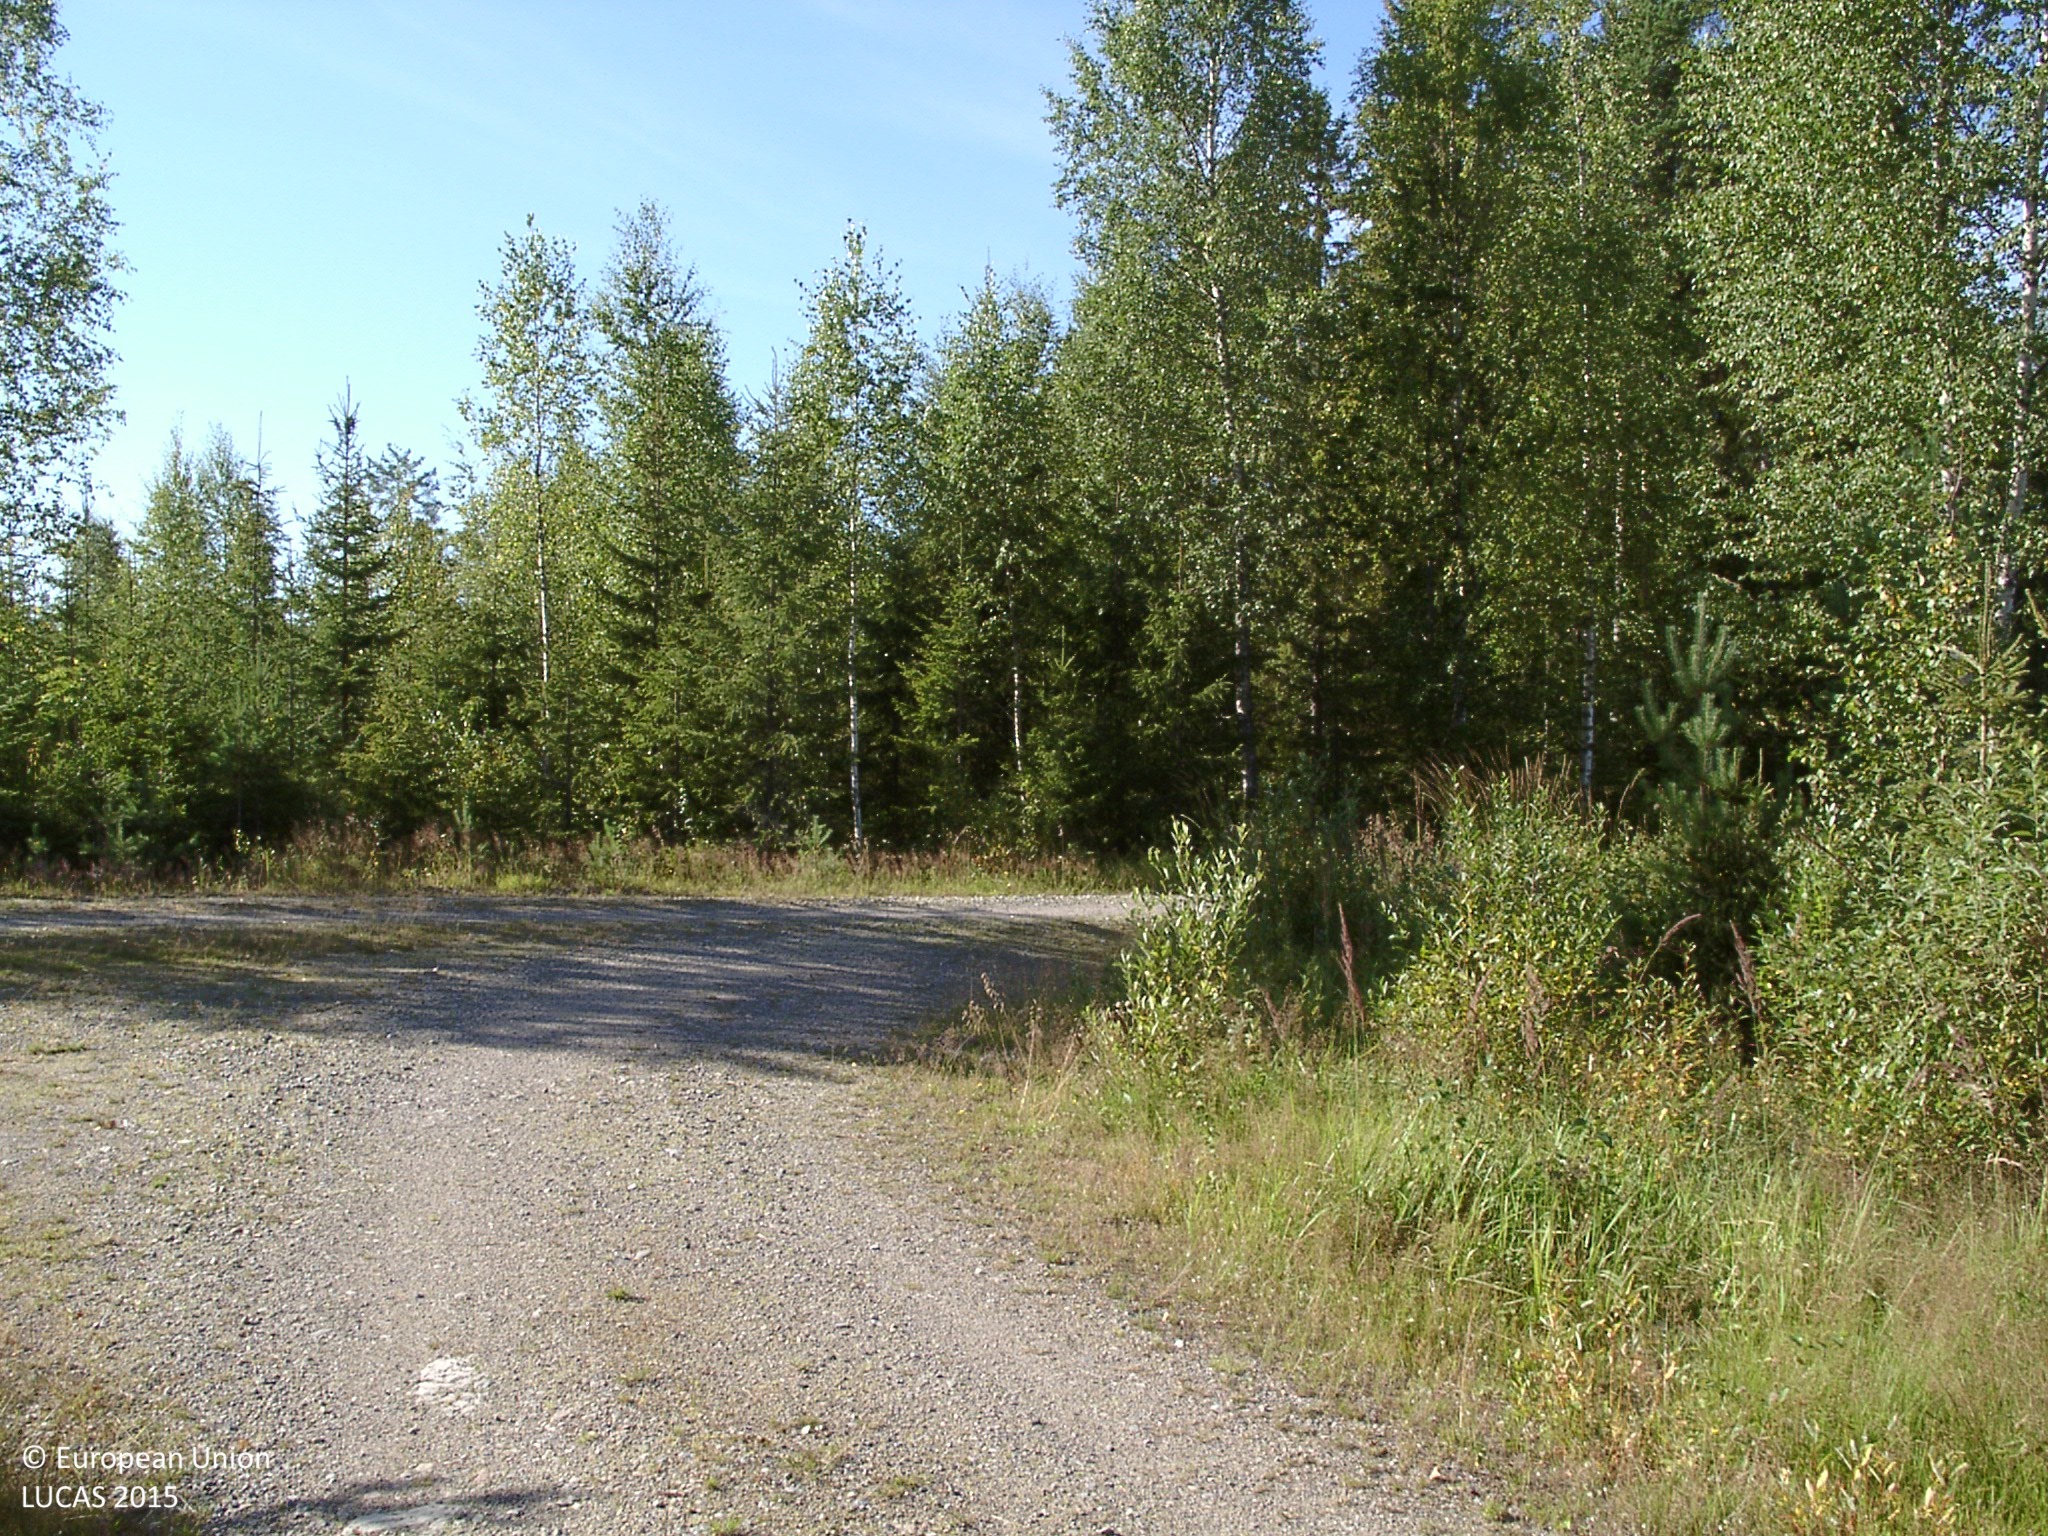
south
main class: Woodland
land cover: Other coniferous woodland
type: boreal forest
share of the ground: 50 - 75 %
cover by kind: coniferous forest trees 65 %, shrubs 10 %, herbaceous plants 5 %, lichens and mosses 5 %
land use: Forestry
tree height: < 5 m
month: August
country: FI
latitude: 61.8949
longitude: 24.9663
